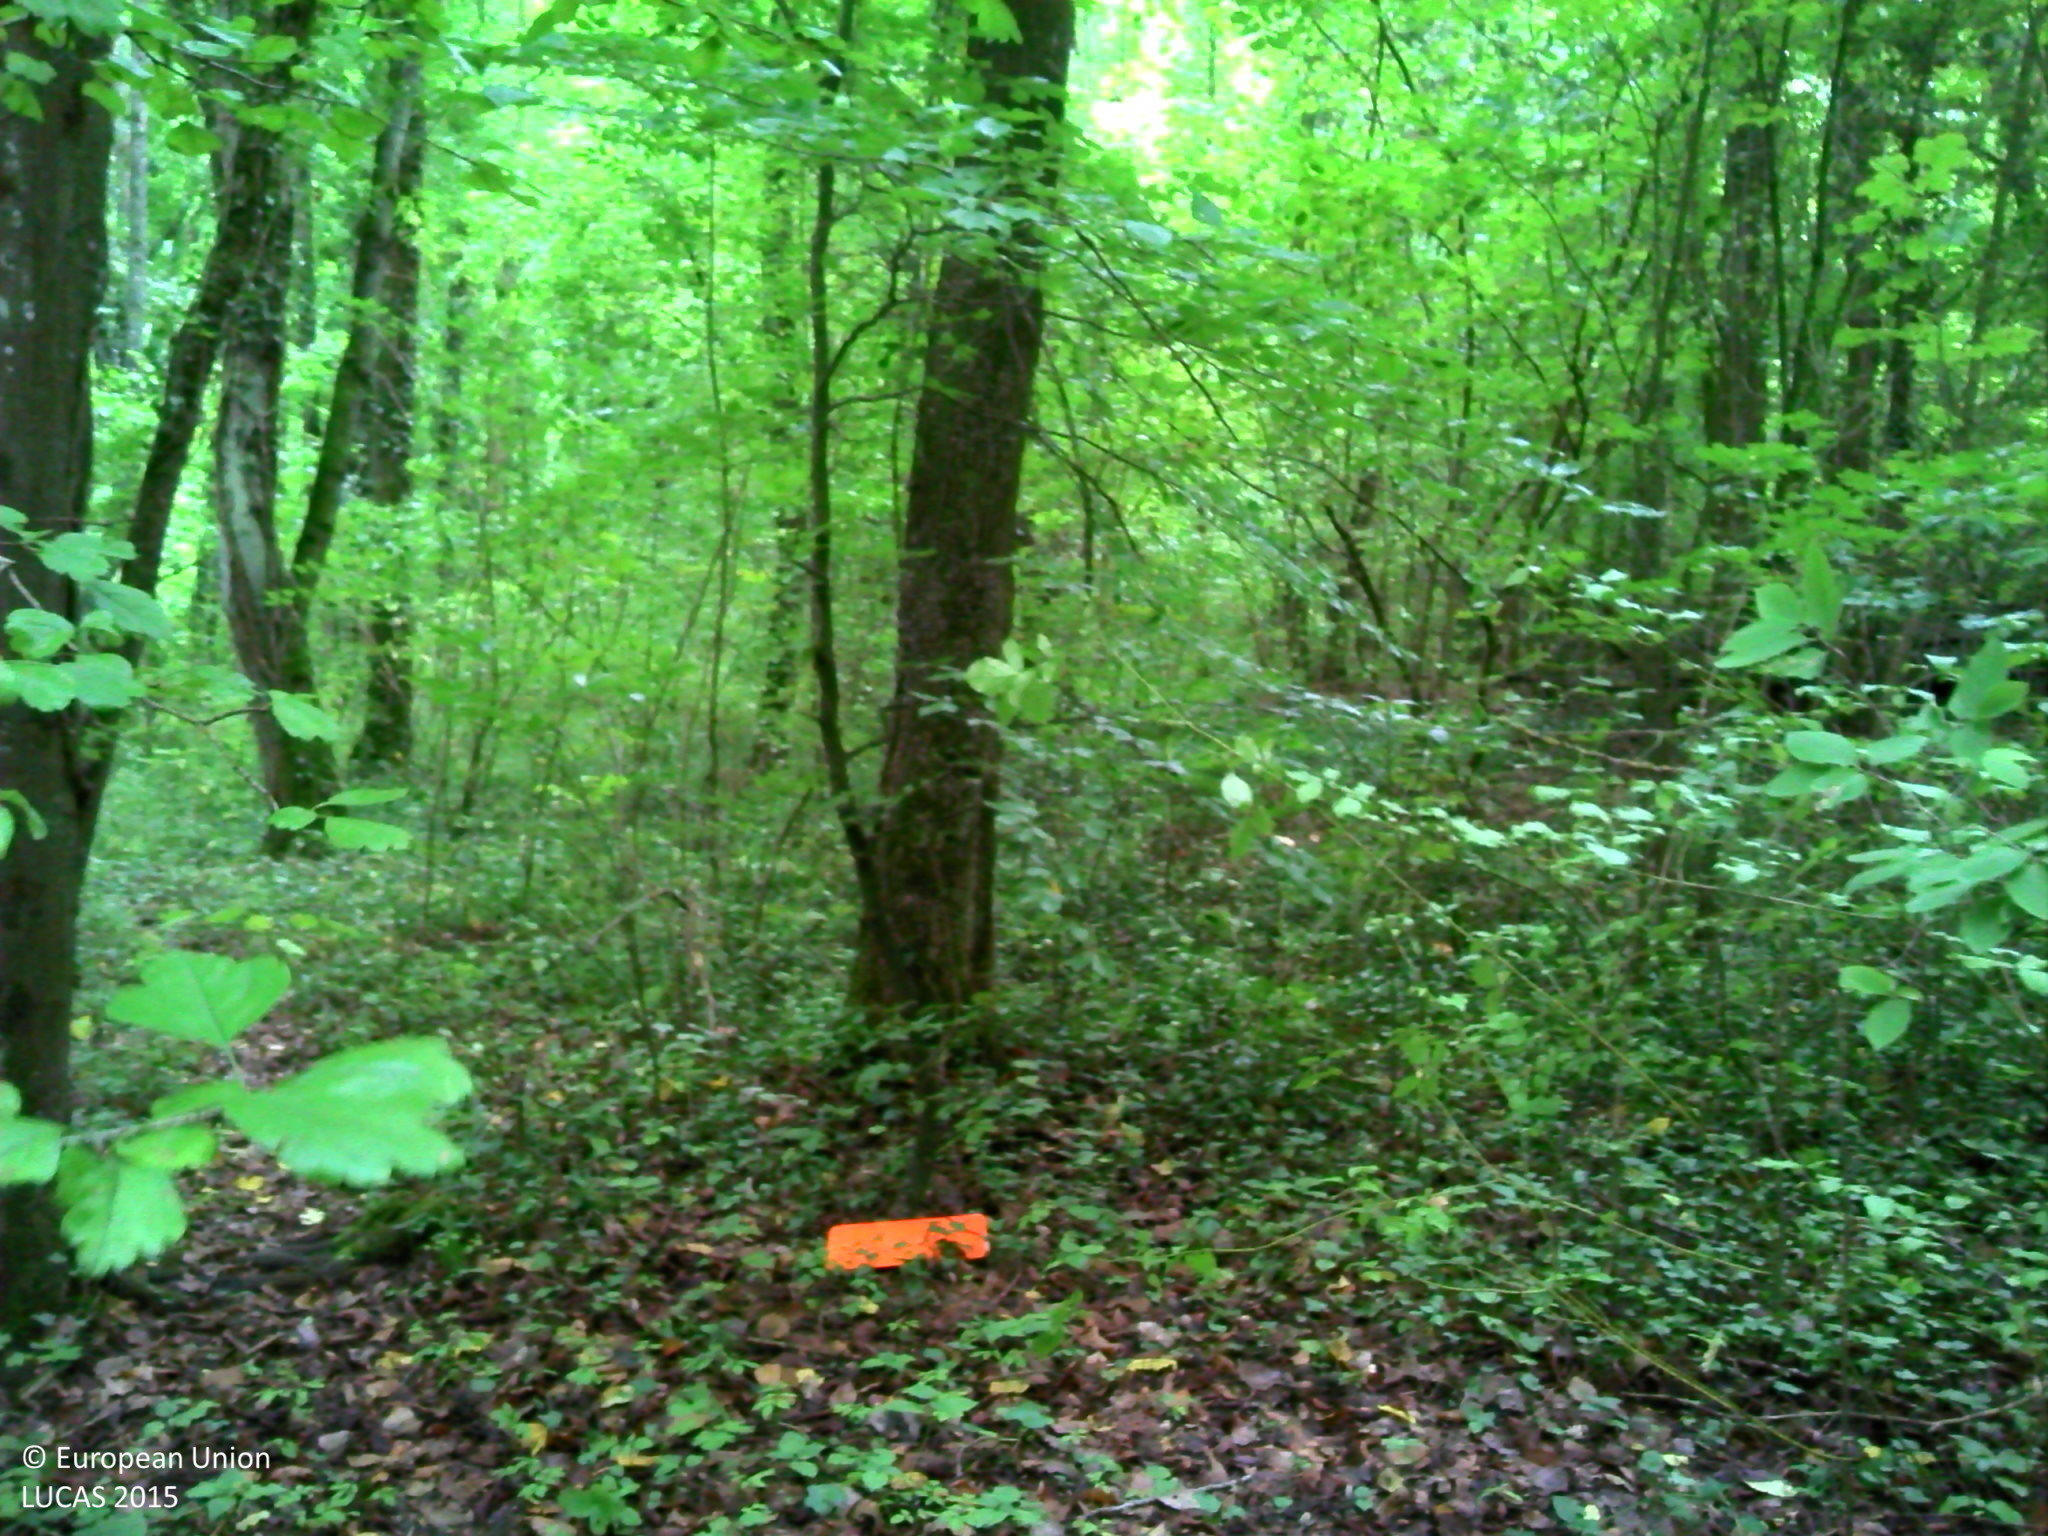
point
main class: Woodland
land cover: Broadleaved woodland
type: mesophytic deciduous forest
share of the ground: > 75 %
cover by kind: broadleaved forest trees 90 %, herbaceous plants 5 %, consolidated bare surface 5 %
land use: Forestry
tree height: > 5 m
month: September
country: FR
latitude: 48.8727
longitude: 6.0322
